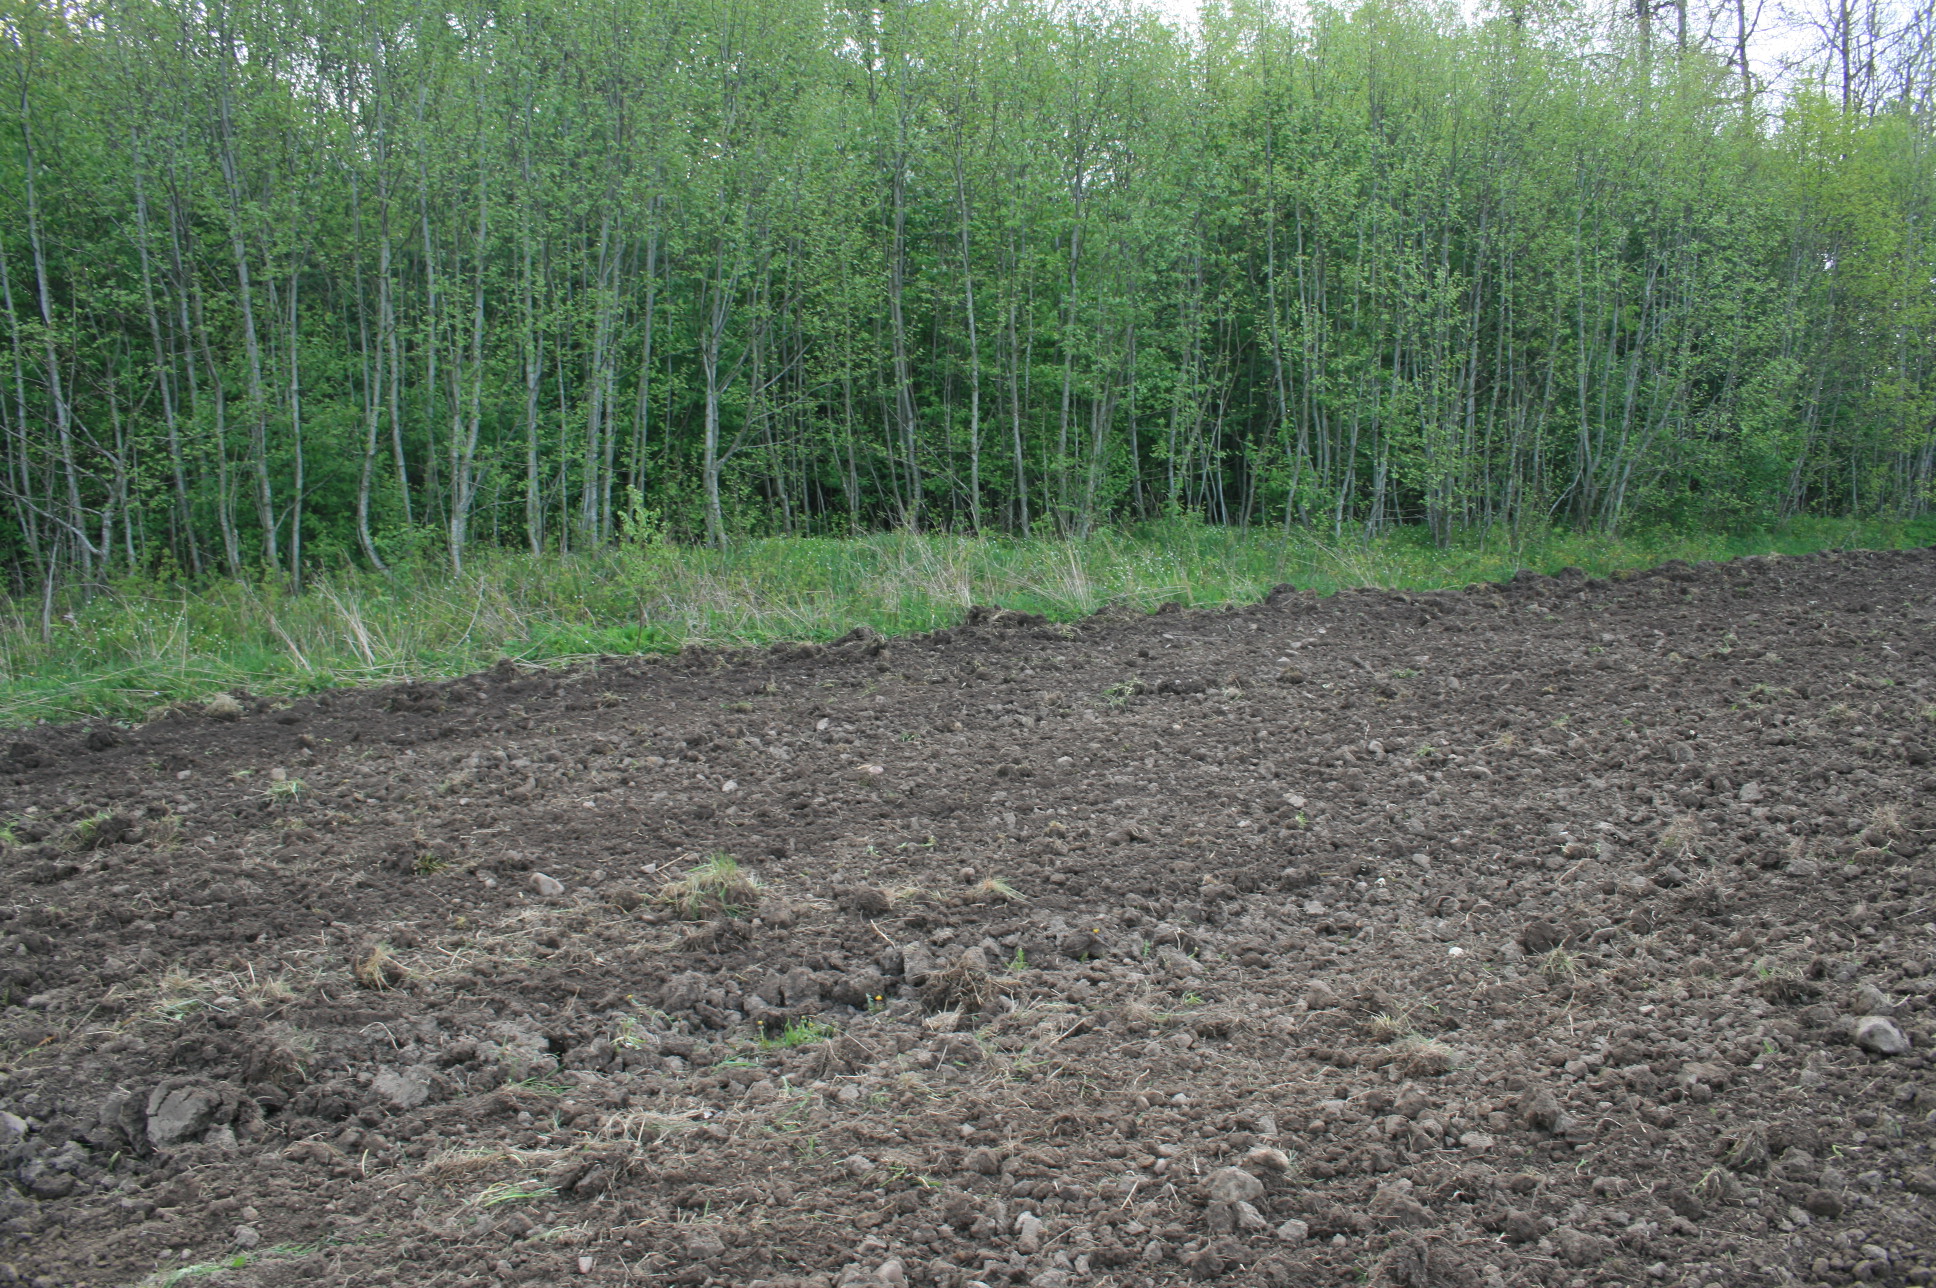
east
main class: Cropland
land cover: Durum wheat
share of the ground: > 75 %
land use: Agriculture (excluding fallow land and kitchen gardens)
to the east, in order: Durum wheat; Grass margins; Broadleaved woodland; Spruce dominated mixed woodland; Broadleaved woodland; Durum wheat
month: May
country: LT
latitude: 56.2403
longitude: 21.6137
